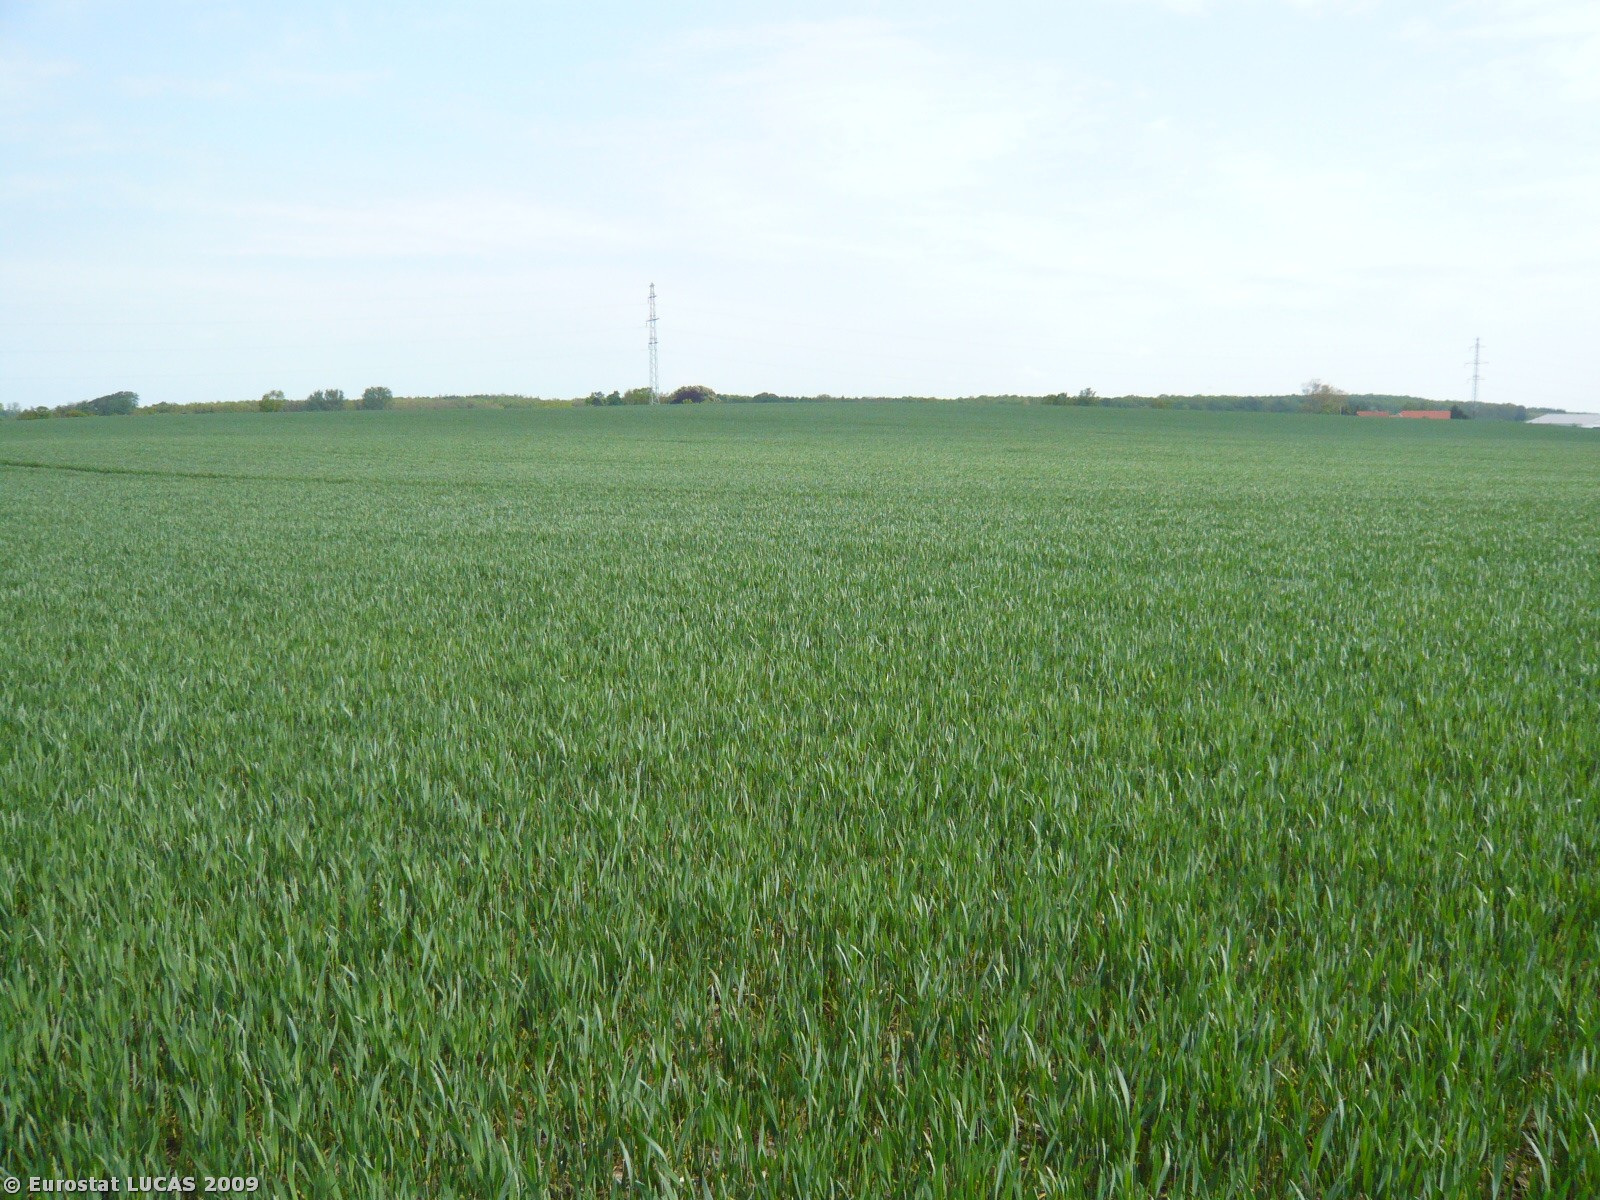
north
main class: Cropland
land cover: Common wheat
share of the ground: > 75 %
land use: Agriculture (excluding fallow land and kitchen gardens)
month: May
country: DK
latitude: 55.3271
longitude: 12.0002
